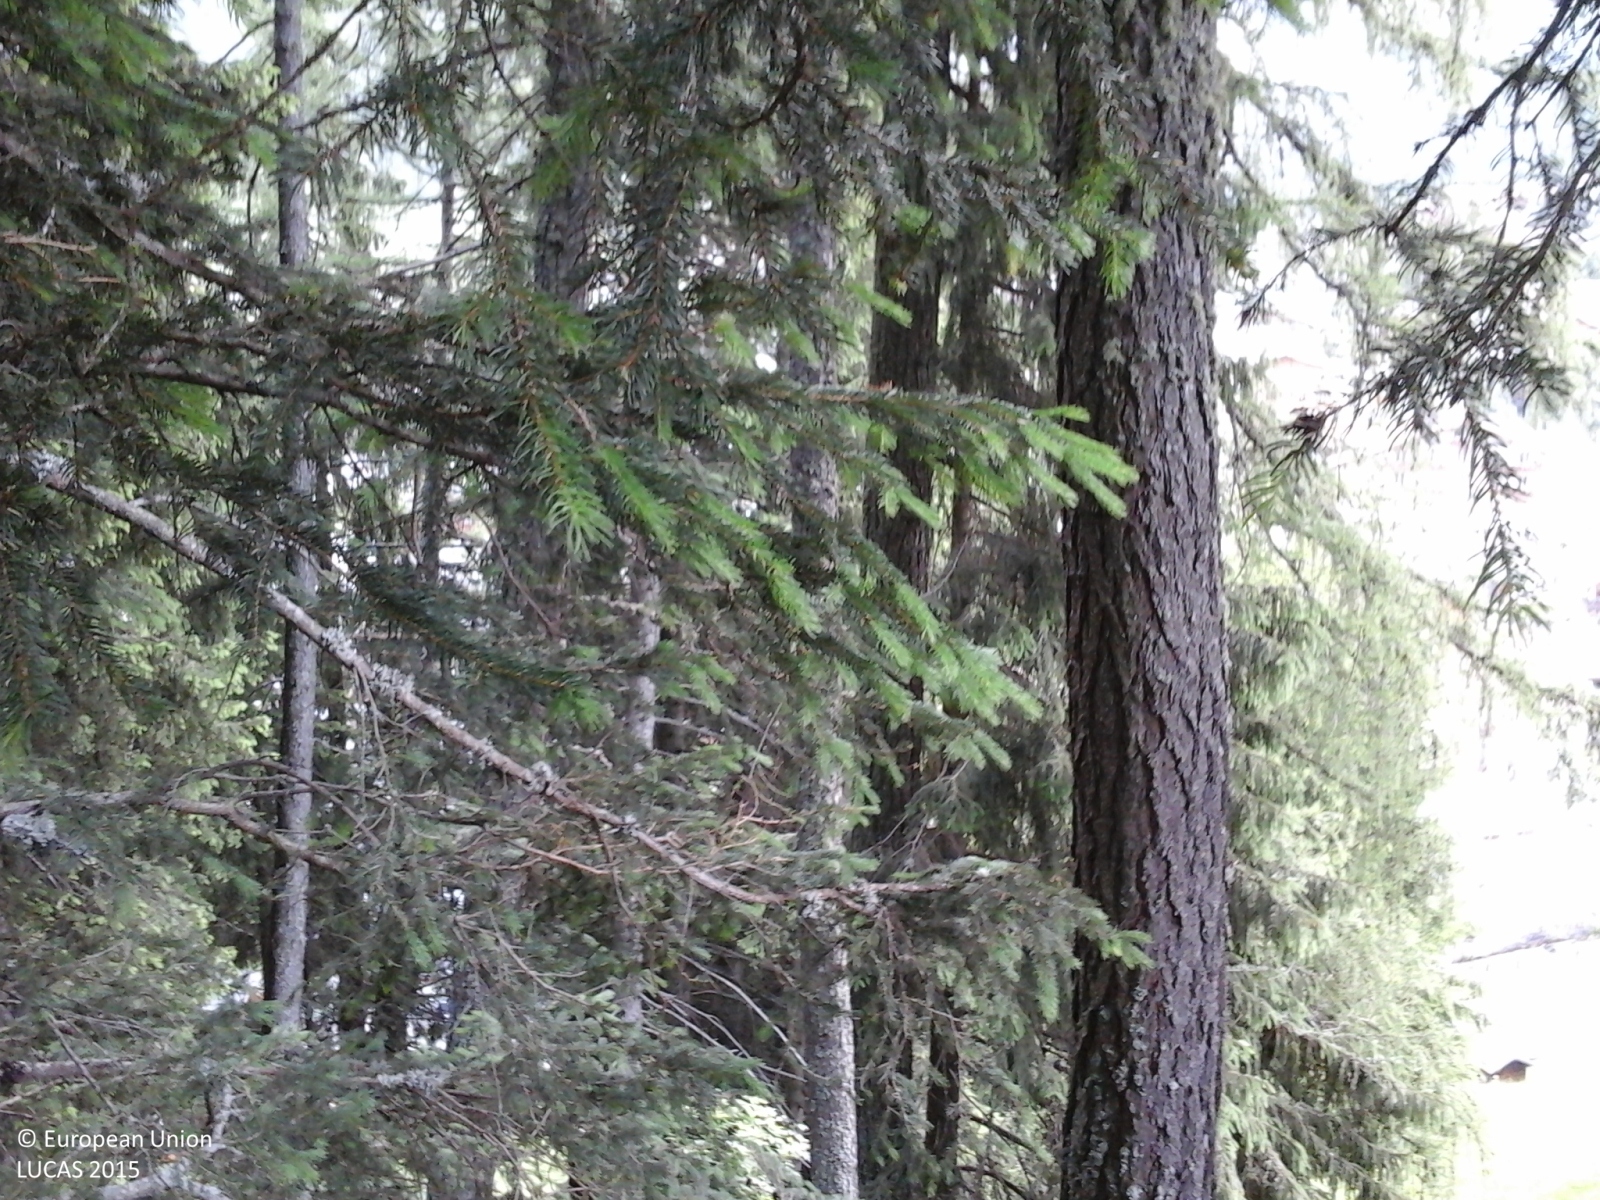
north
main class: Woodland
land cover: Spruce dominated coniferous woodland
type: alpine coniferous forest
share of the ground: > 75 %
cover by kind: coniferous forest trees 100 %
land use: Forestry
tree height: > 5 m
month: June
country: IT
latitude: 46.5529
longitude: 11.7588
